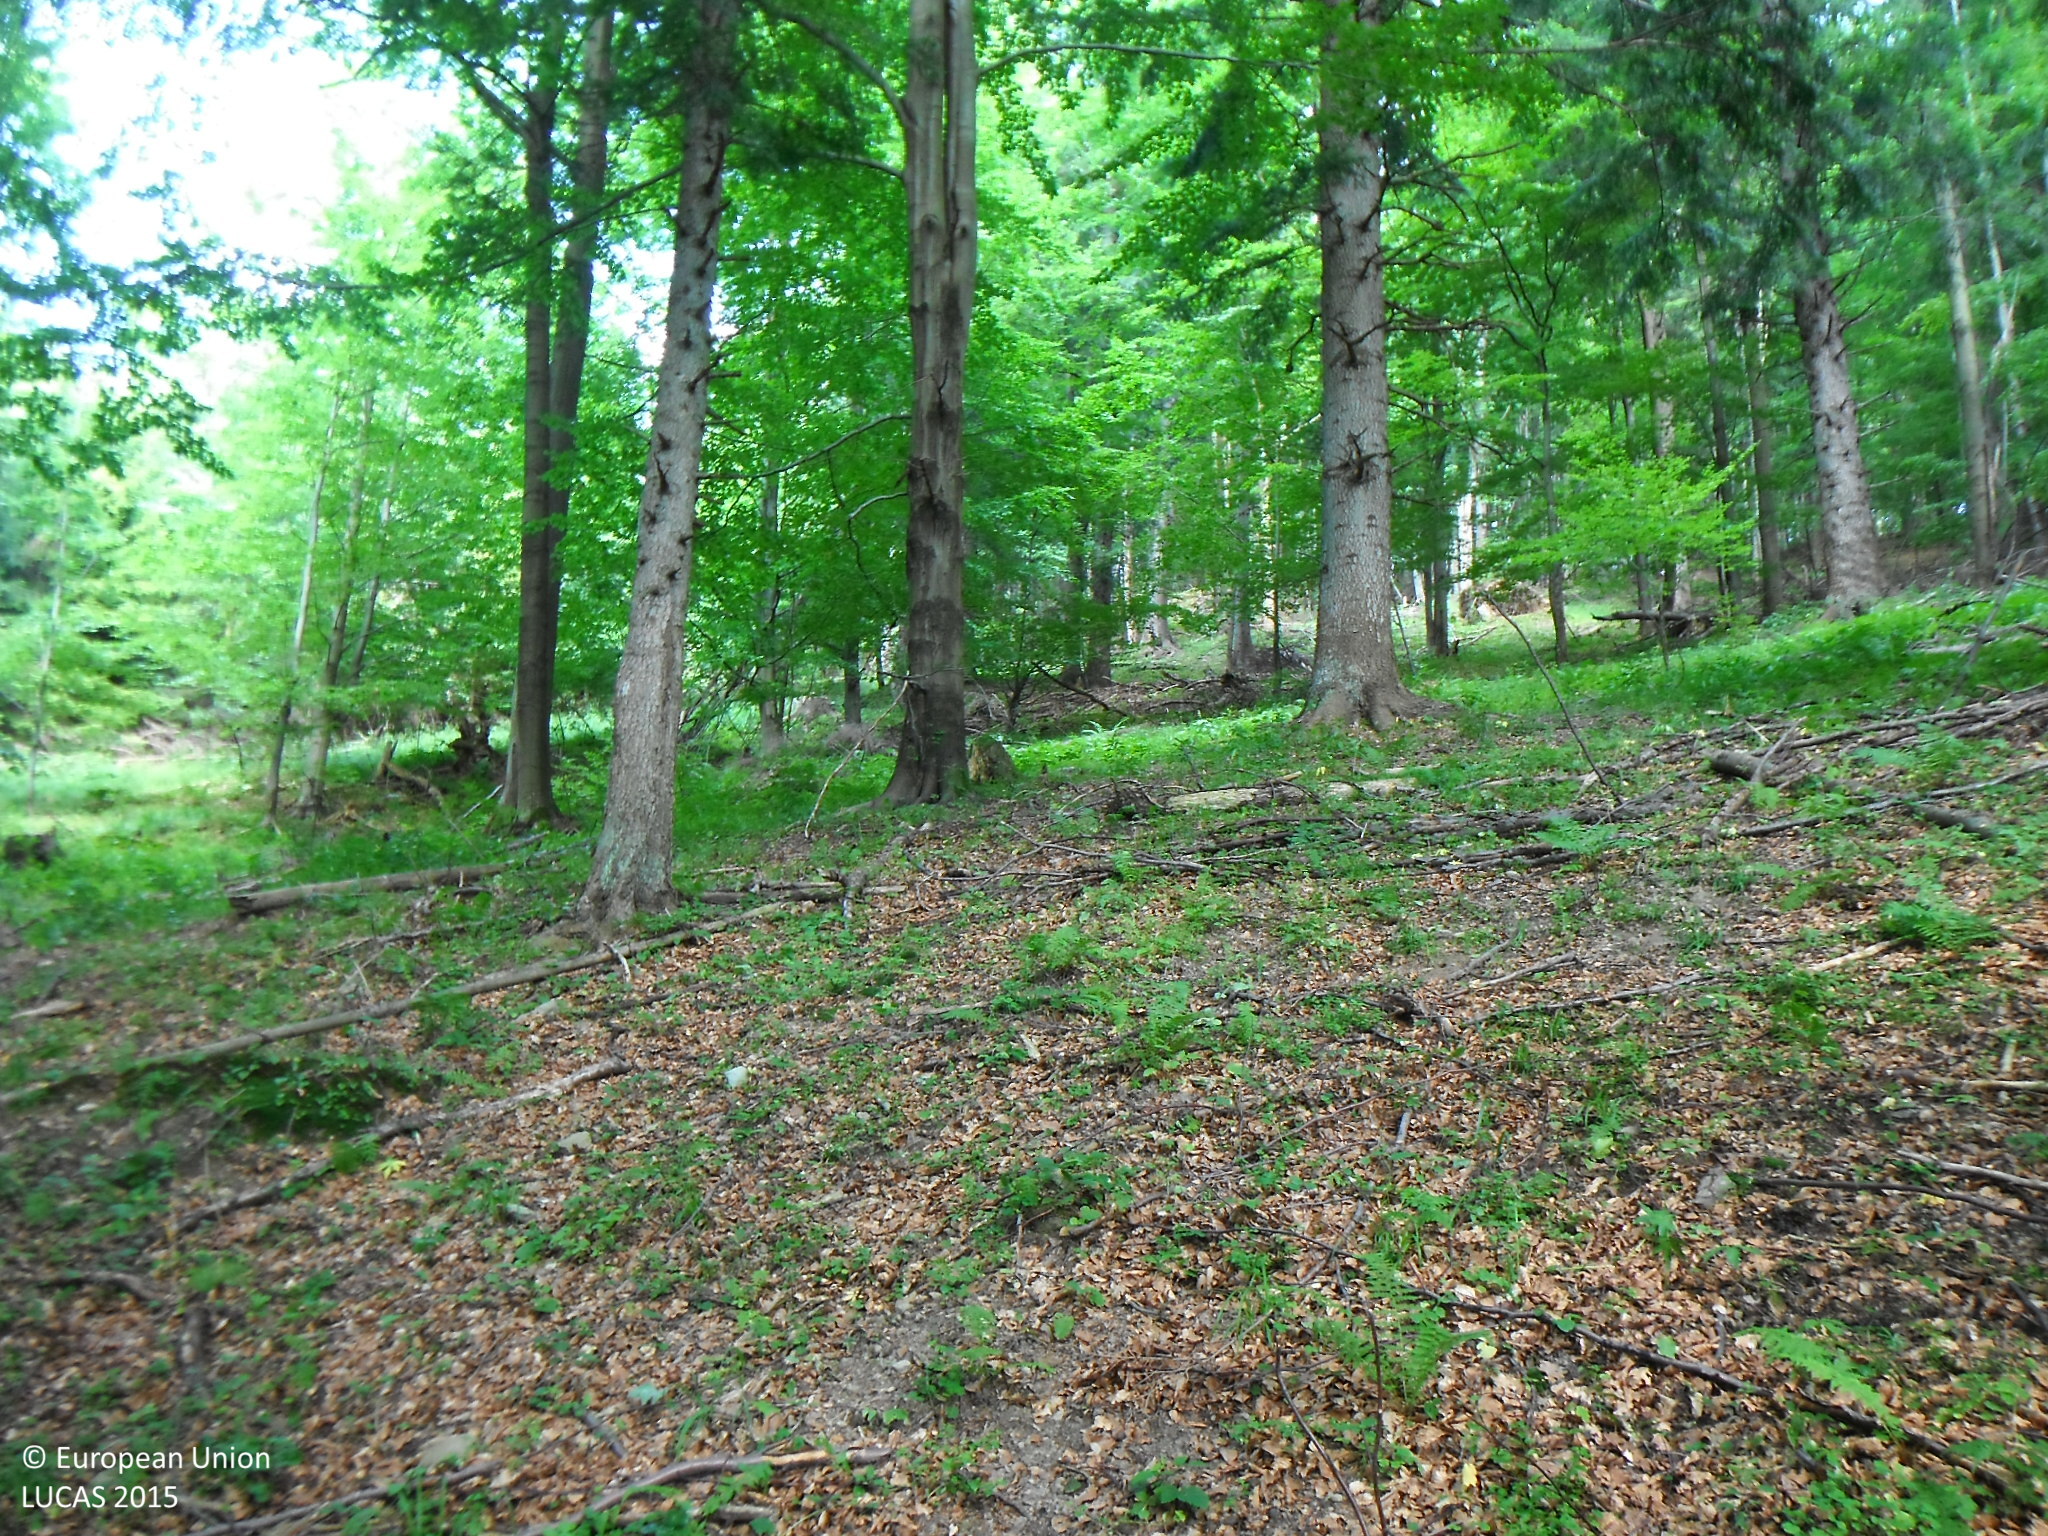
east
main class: Woodland
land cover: Other mixed woodland
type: alpine coniferous forest
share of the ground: > 75 %
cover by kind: coniferous forest trees 45 %, broadleaved forest trees 45 %, herbaceous plants 10 %
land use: Forestry
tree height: > 5 m
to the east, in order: Other mixed woodland; Broadleaved woodland
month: July
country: SK
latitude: 49.2517
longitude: 20.9918
